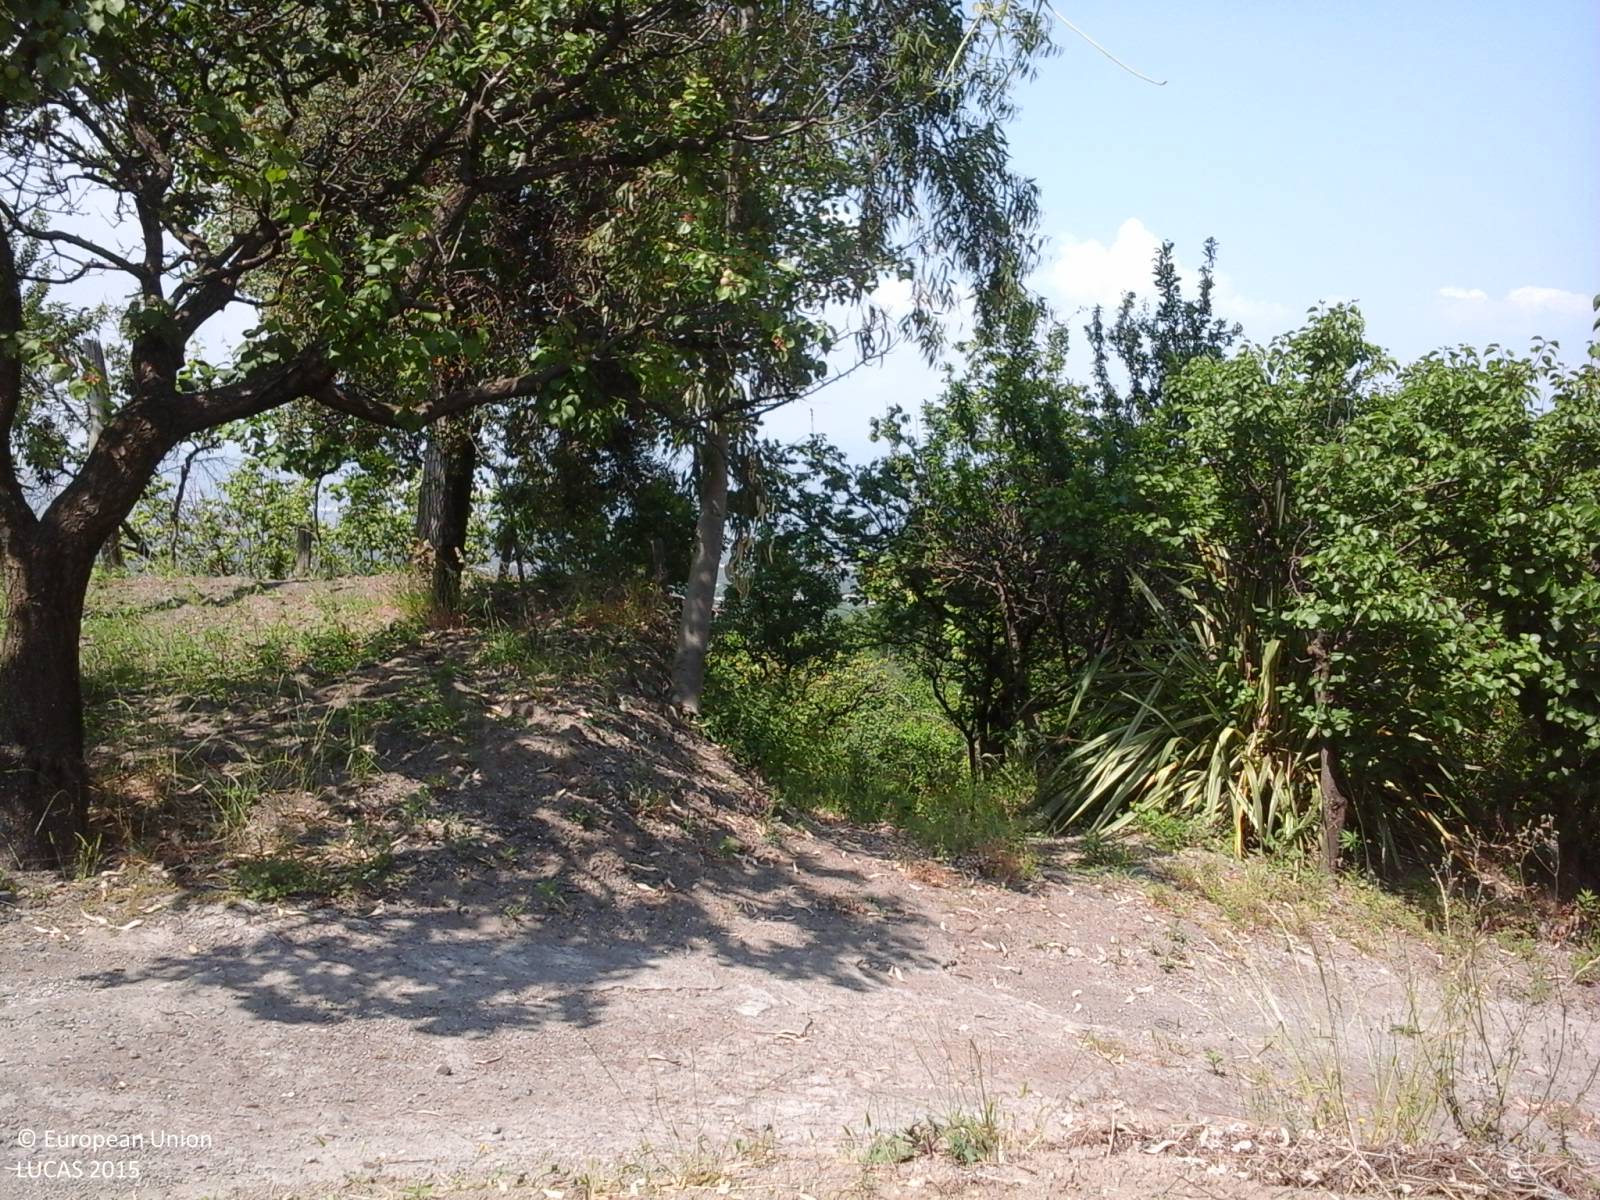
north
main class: Cropland
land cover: Vineyards
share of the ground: > 75 %
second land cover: Other bare soil
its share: > 75 %
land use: Agriculture (excluding fallow land and kitchen gardens)
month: June
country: IT
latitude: 40.8547
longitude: 14.4538
